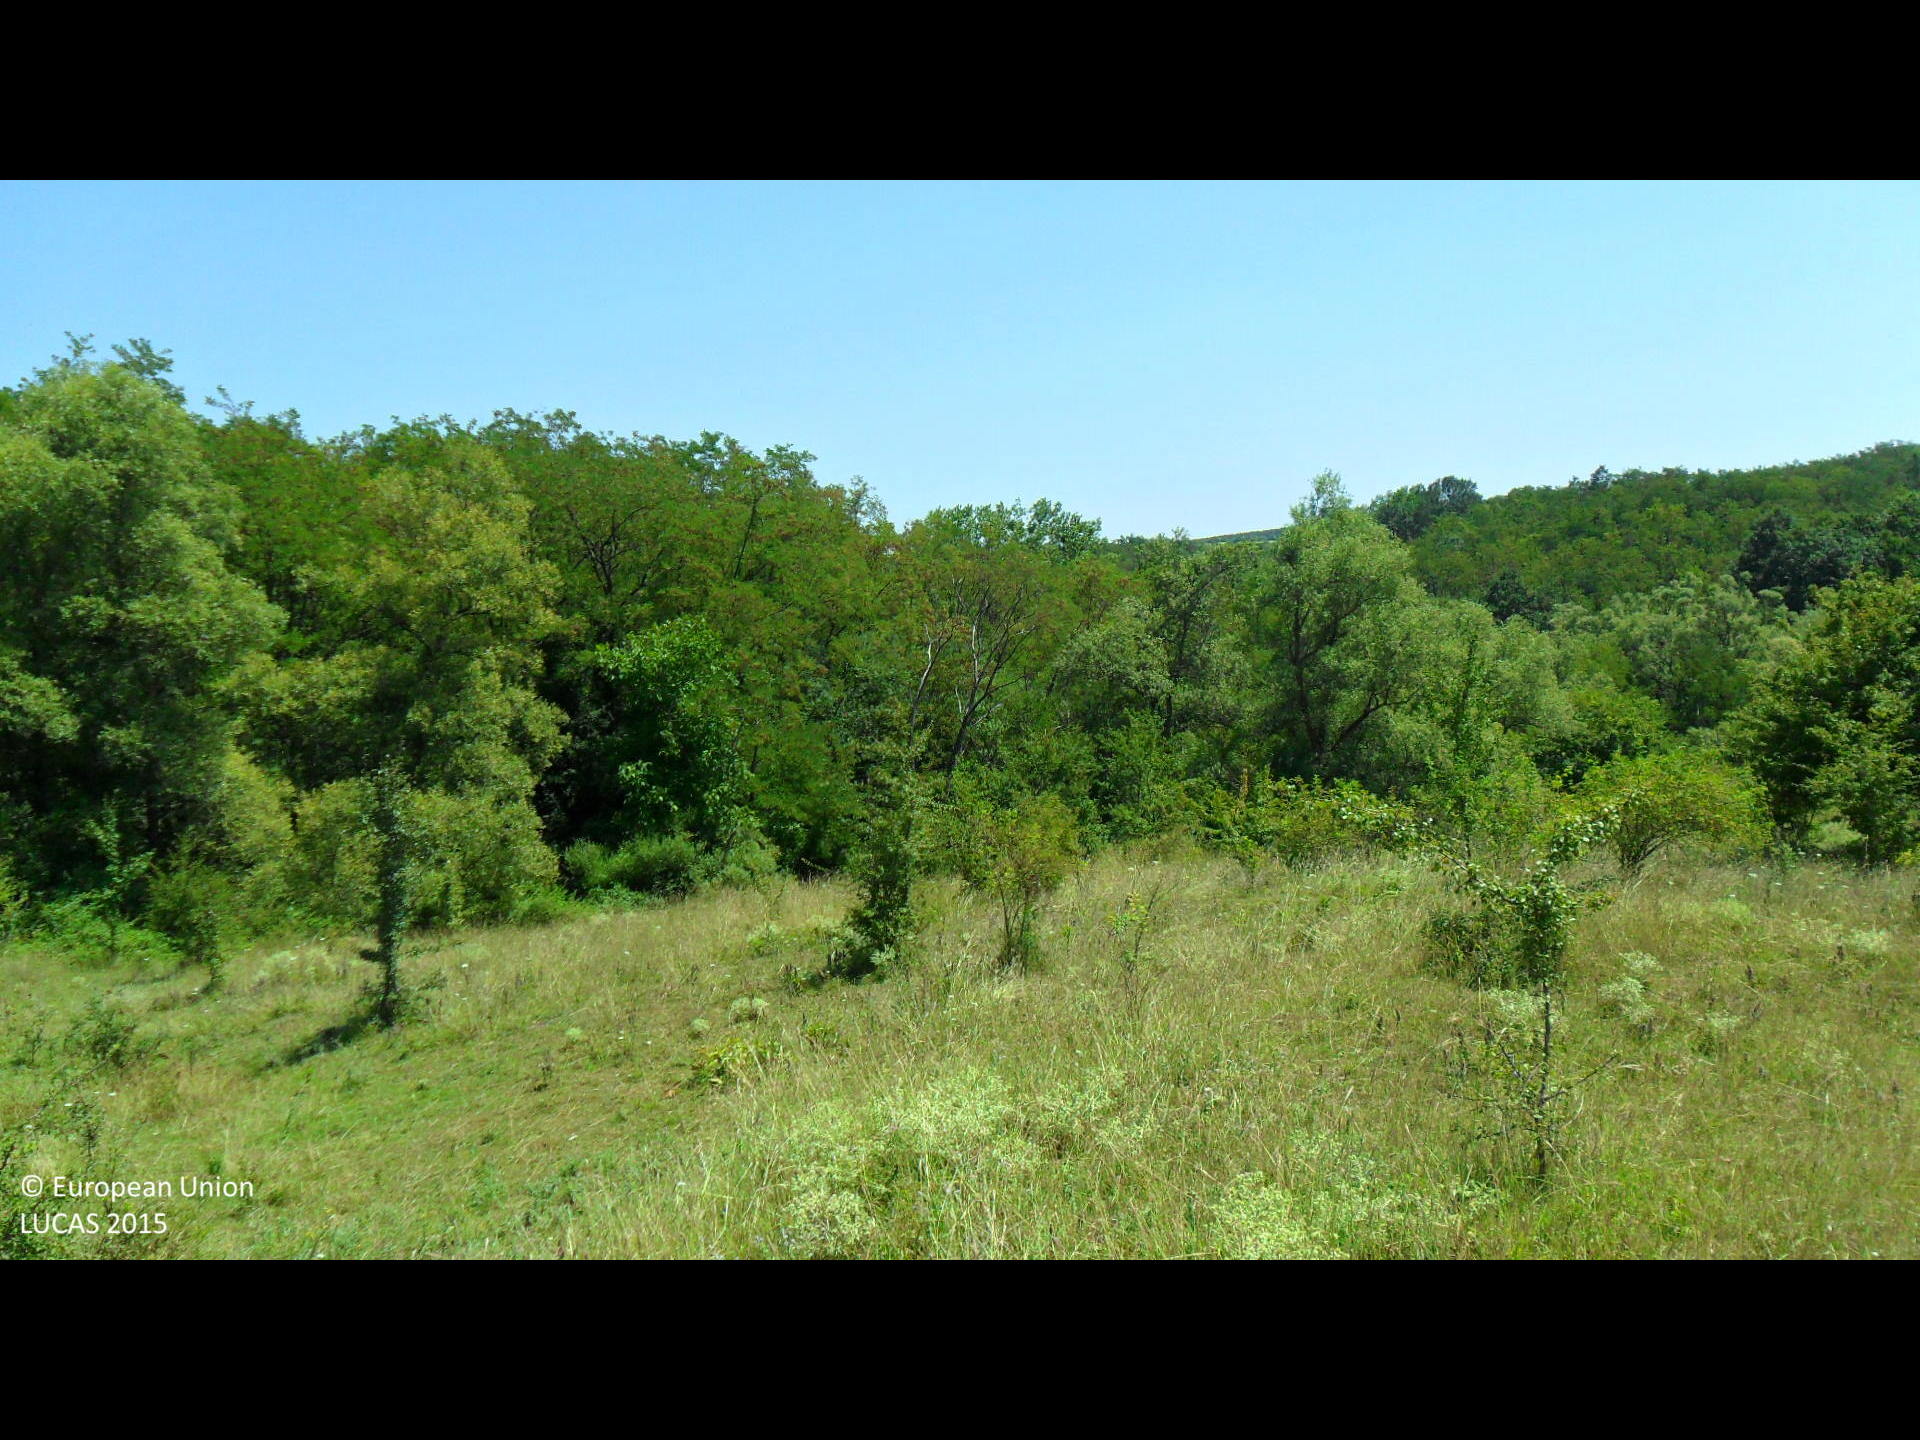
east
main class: Grassland
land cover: Grassland with sparse tree/shrub cover
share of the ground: > 75 %
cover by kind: herbaceous plants 90 %, broadleaved forest trees 5 %, shrubs 5 %
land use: Agriculture (excluding fallow land and kitchen gardens)
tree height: > 5 m
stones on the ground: < 10 %
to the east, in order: Grassland with sparse tree/shrub cover; Ditches and canals; Broadleaved woodland
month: August
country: BG
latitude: 43.3204
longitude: 26.1112
